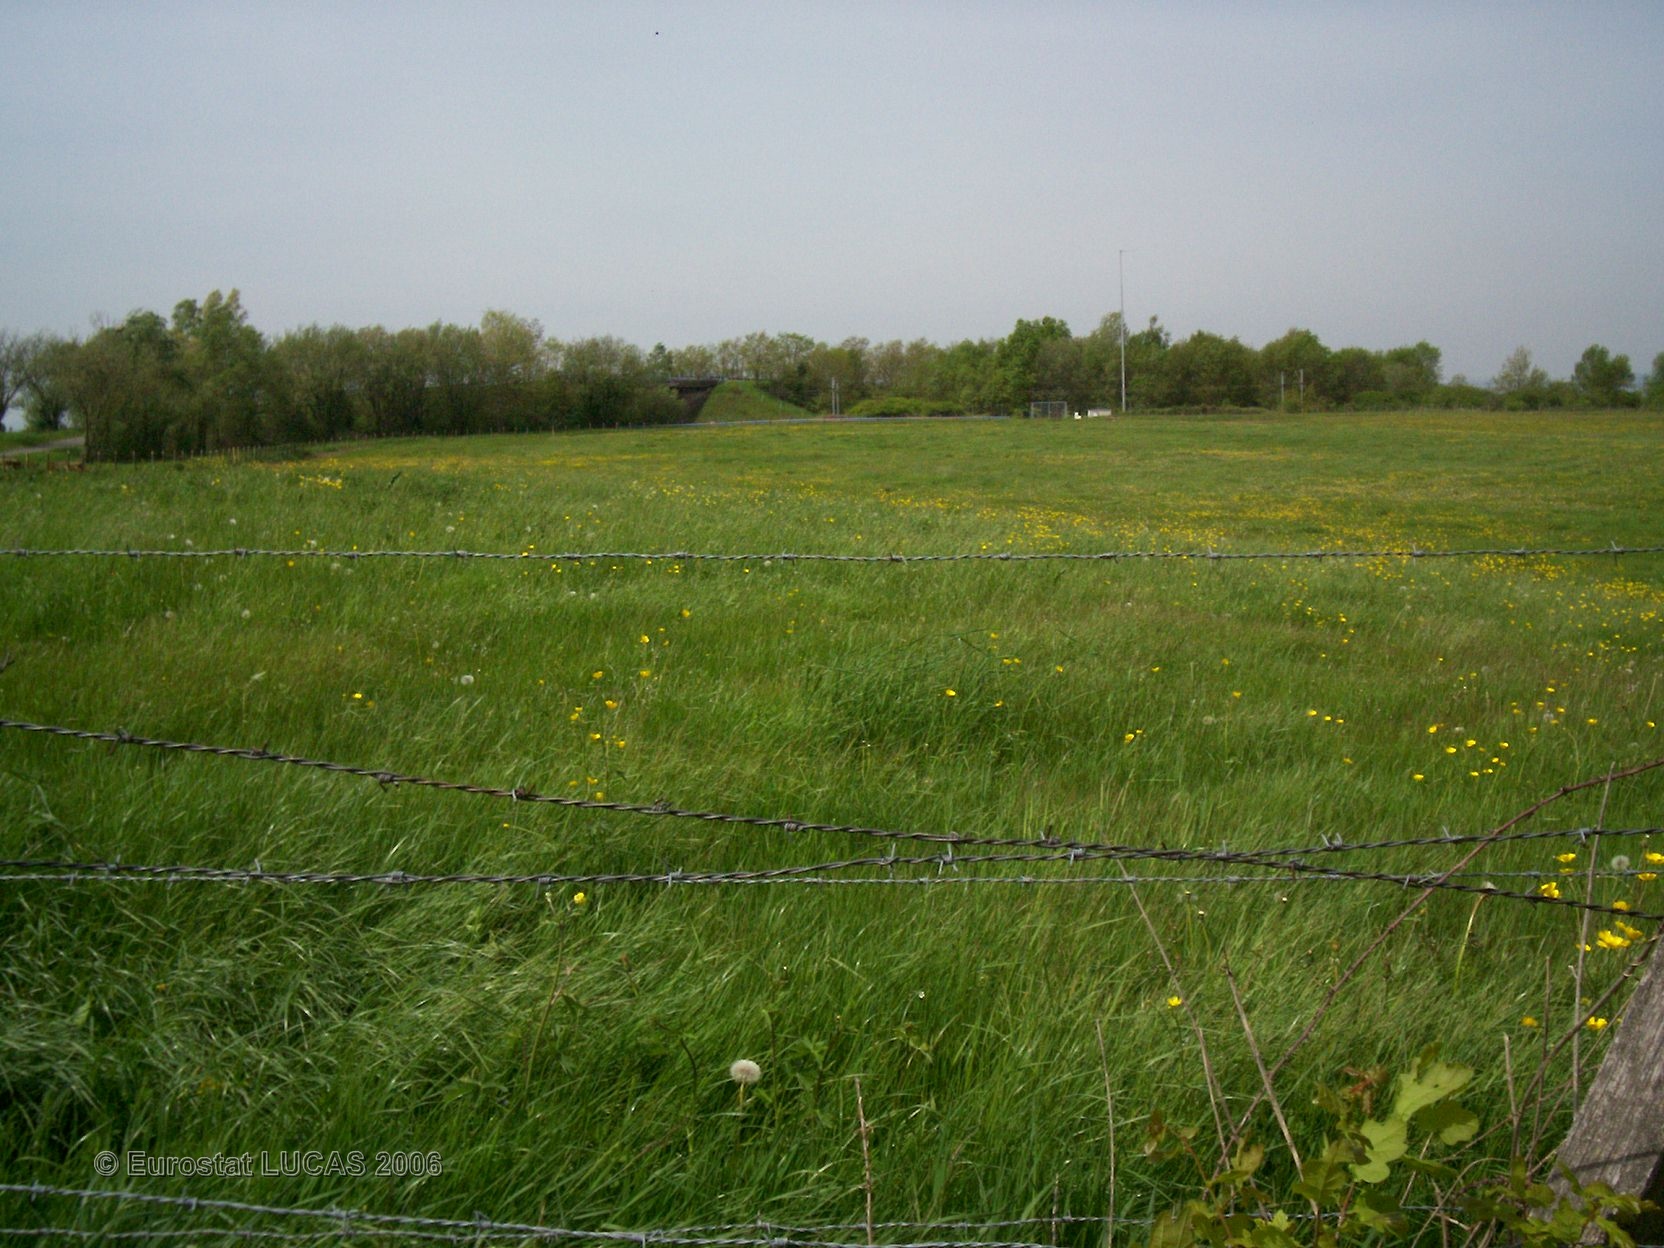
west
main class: Cropland
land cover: Common wheat
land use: Agriculture (excluding fallow land and kitchen gardens)
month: May
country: FR
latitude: 46.1915
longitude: 4.8586
